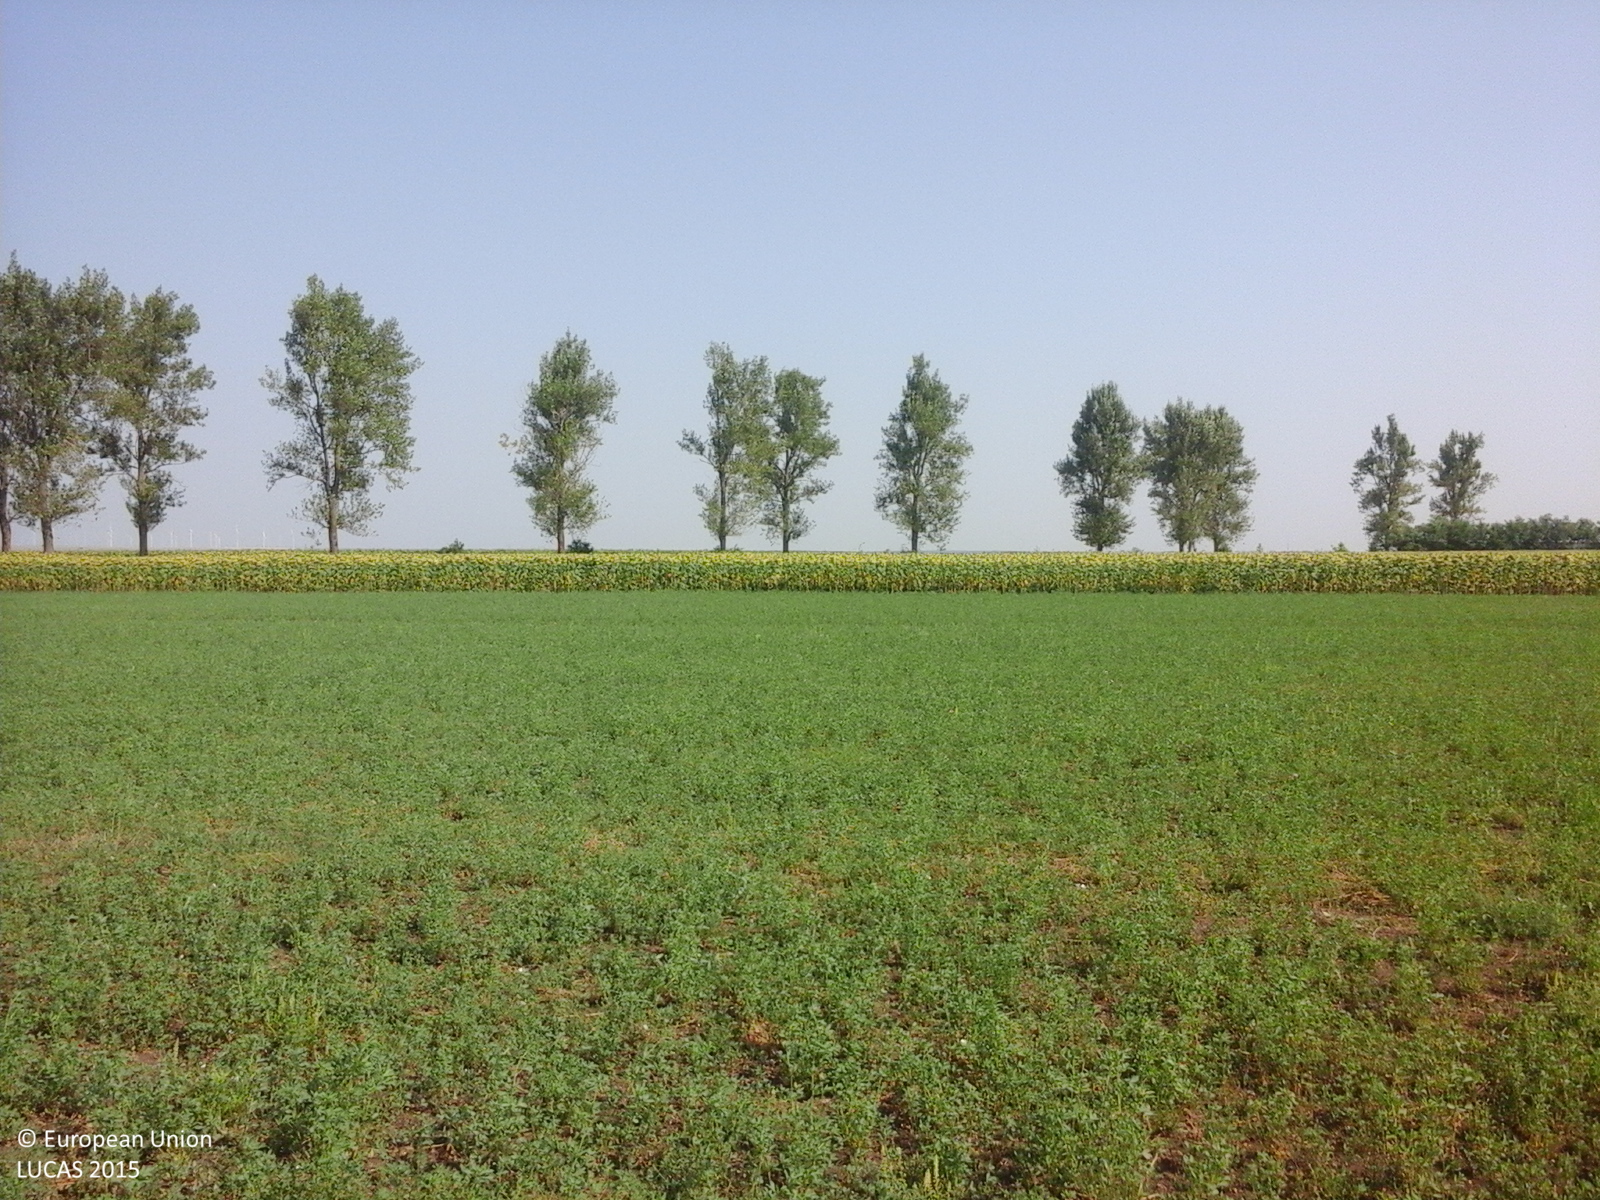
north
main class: Cropland
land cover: Lucerne
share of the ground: > 75 %
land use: Agriculture (excluding fallow land and kitchen gardens)
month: July
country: RO
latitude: 45.7173
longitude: 27.8571
